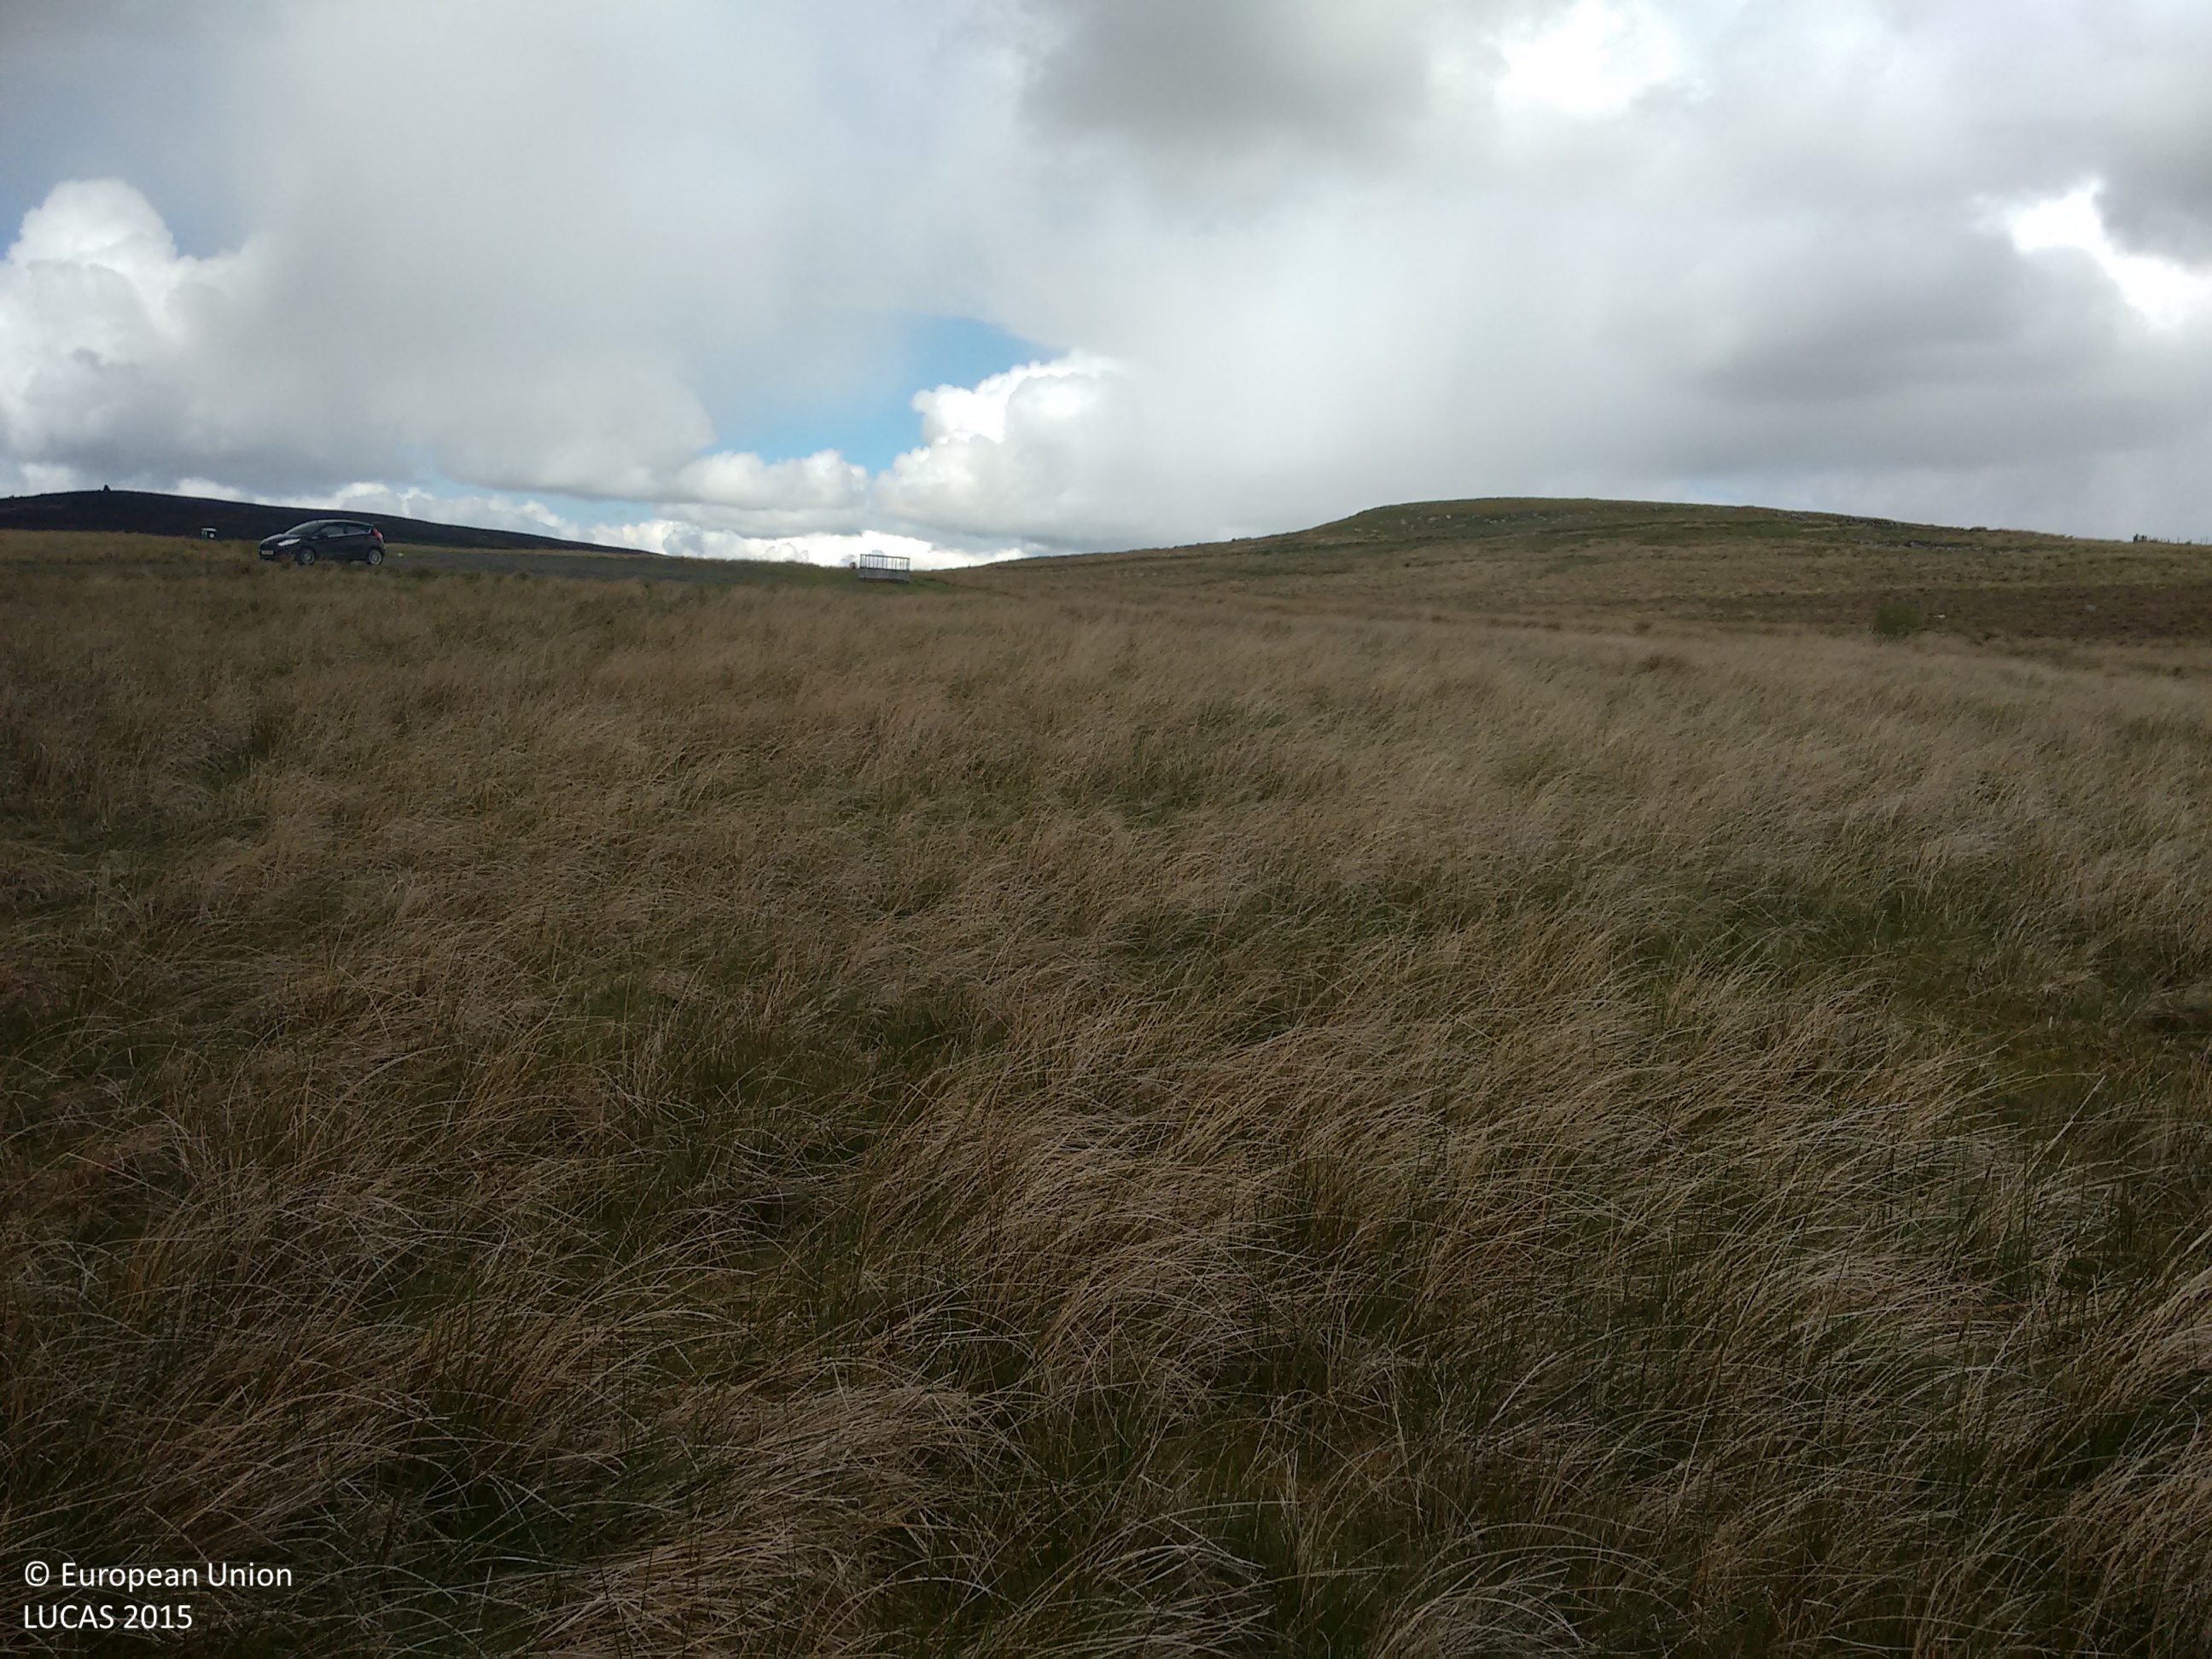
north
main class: Grassland
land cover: Grassland without tree/shrub cover
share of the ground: > 75 %
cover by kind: herbaceous plants 100 %
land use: Agriculture (excluding fallow land and kitchen gardens)
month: May
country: GB
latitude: 55.3021
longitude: -2.2974
